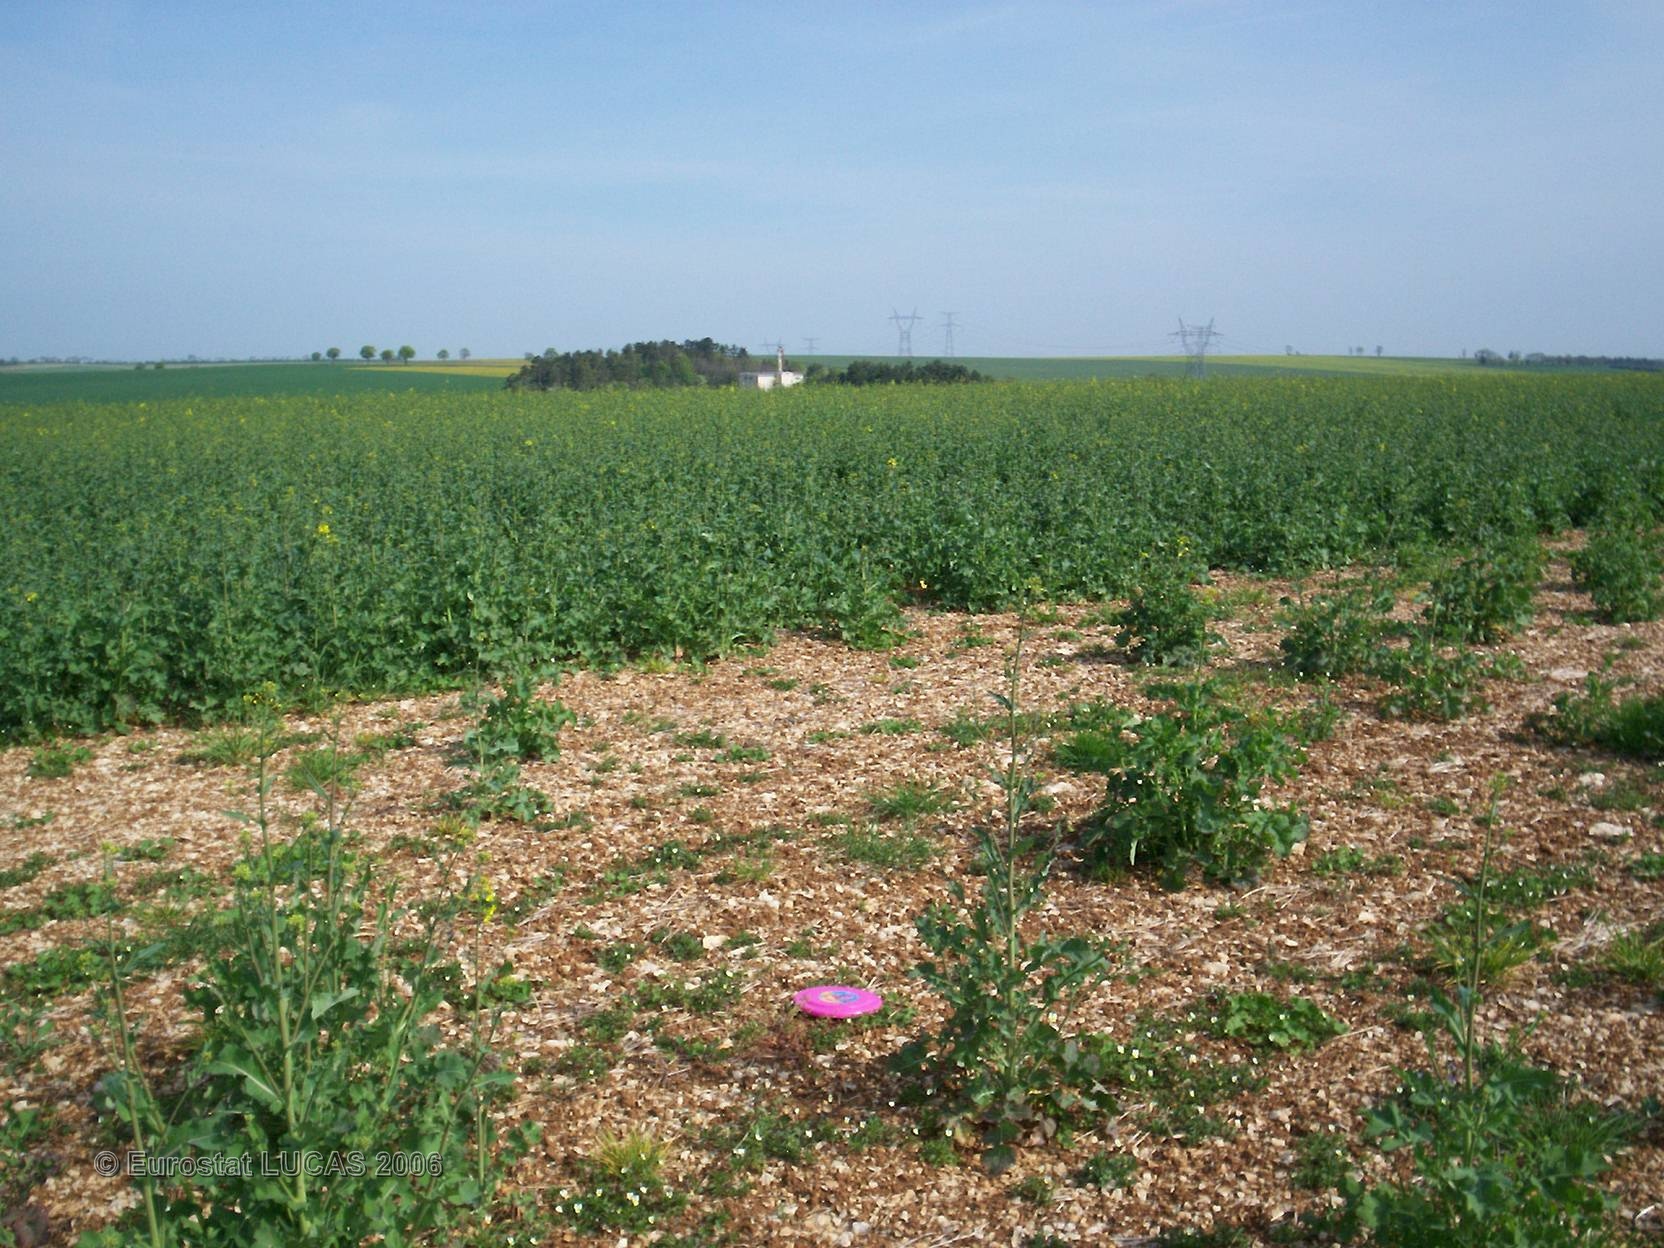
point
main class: Cropland
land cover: Rape and turnip rape
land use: Agriculture (excluding fallow land and kitchen gardens)
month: May
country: FR
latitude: 47.5843
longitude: 4.5608
